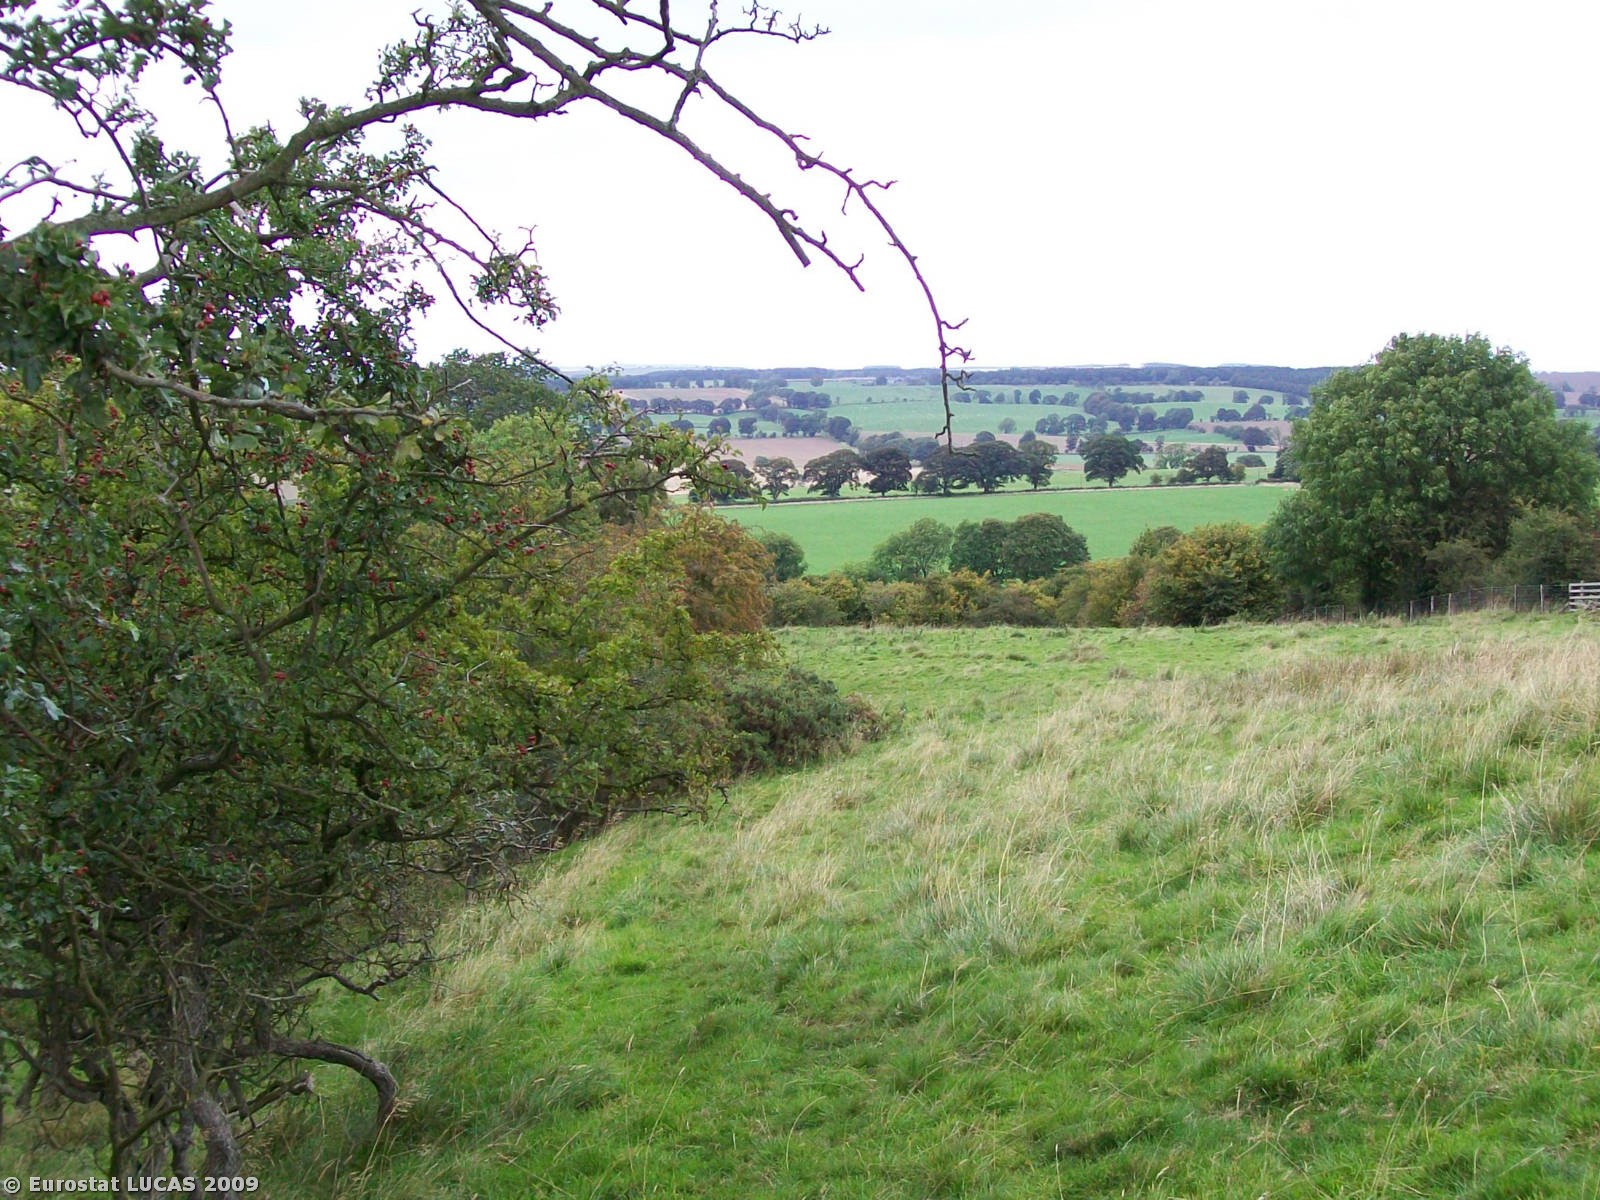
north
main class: Woodland
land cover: Broadleaved woodland
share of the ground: > 75 %
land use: Agriculture (excluding fallow land and kitchen gardens)
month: September
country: GB
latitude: 55.0315
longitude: -2.0870
